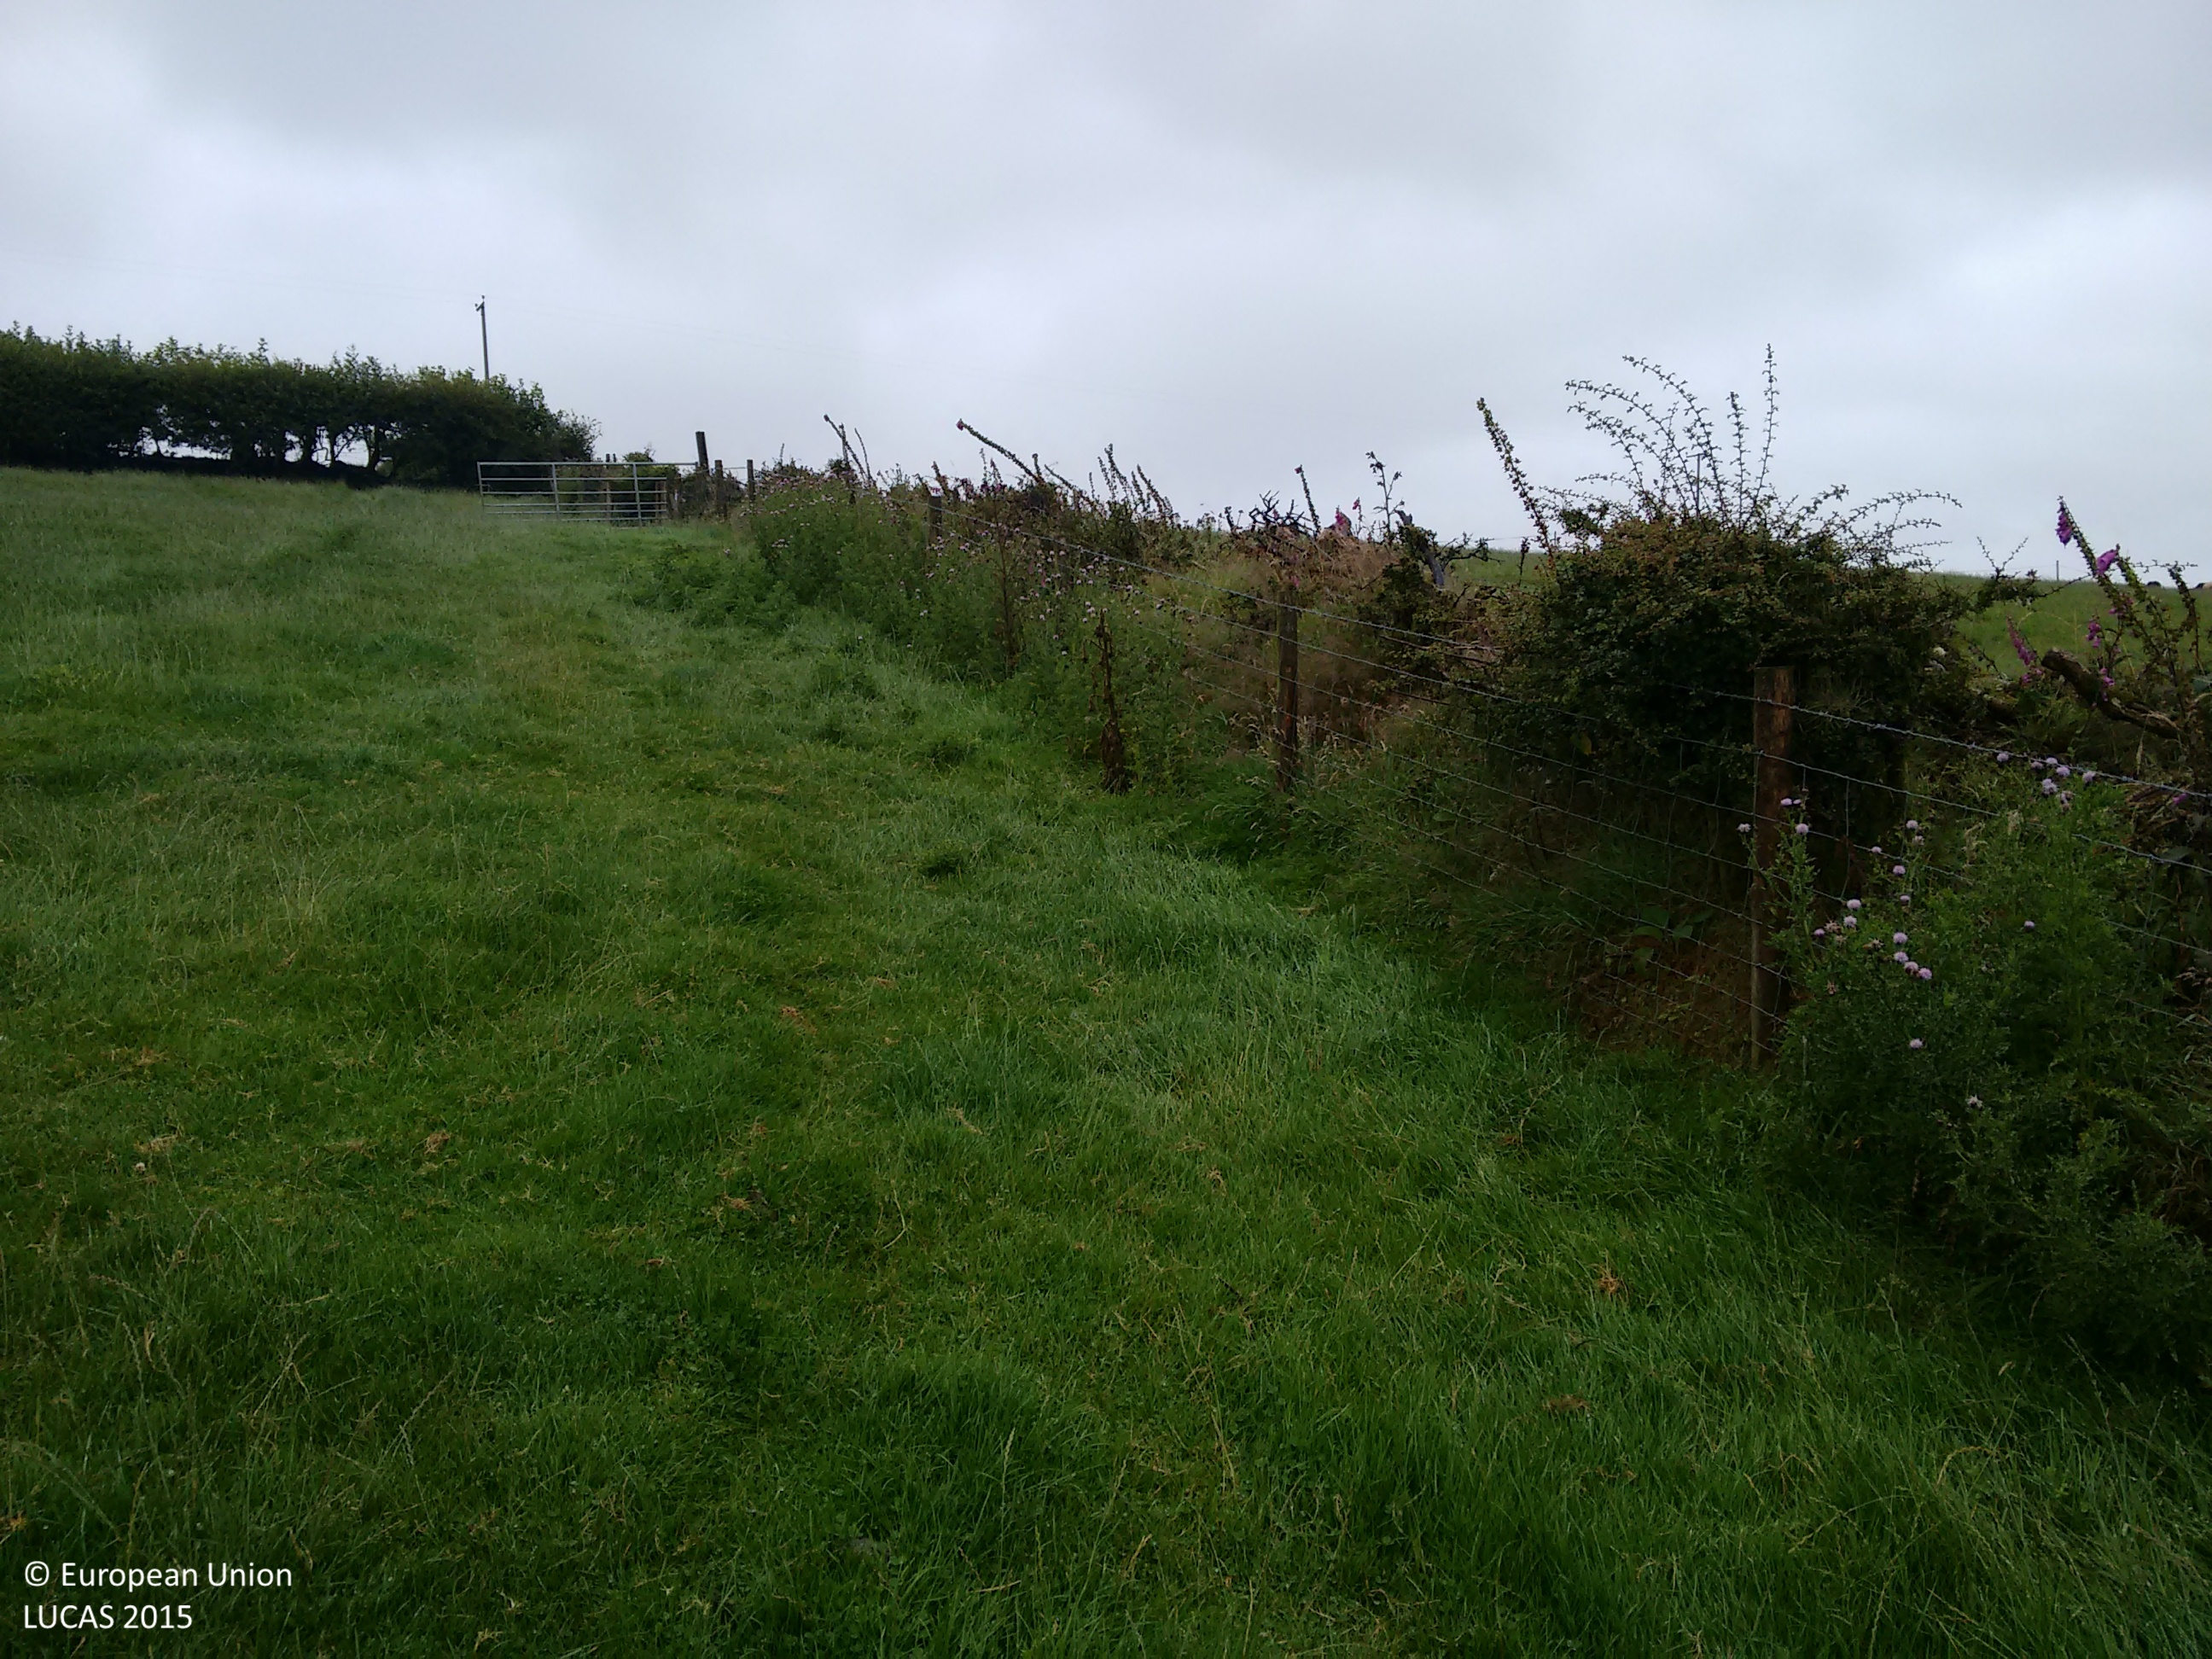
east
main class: Grassland
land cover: Grassland without tree/shrub cover
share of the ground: > 75 %
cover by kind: herbaceous plants 100 %
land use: Agriculture (excluding fallow land and kitchen gardens)
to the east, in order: Grassland without tree/shrub cover; Fences; Shruby margins; Fences; Grassland without tree/shrub cover; Electric lines; Grassland without tree/shrub cover; Fences; Managed hedges; Electric lines; Paved roads, cycling and walking lanes; Managed hedges; Fences; Grassland without tree/shrub cover
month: August
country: GB
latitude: 51.9072
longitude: -4.4511
